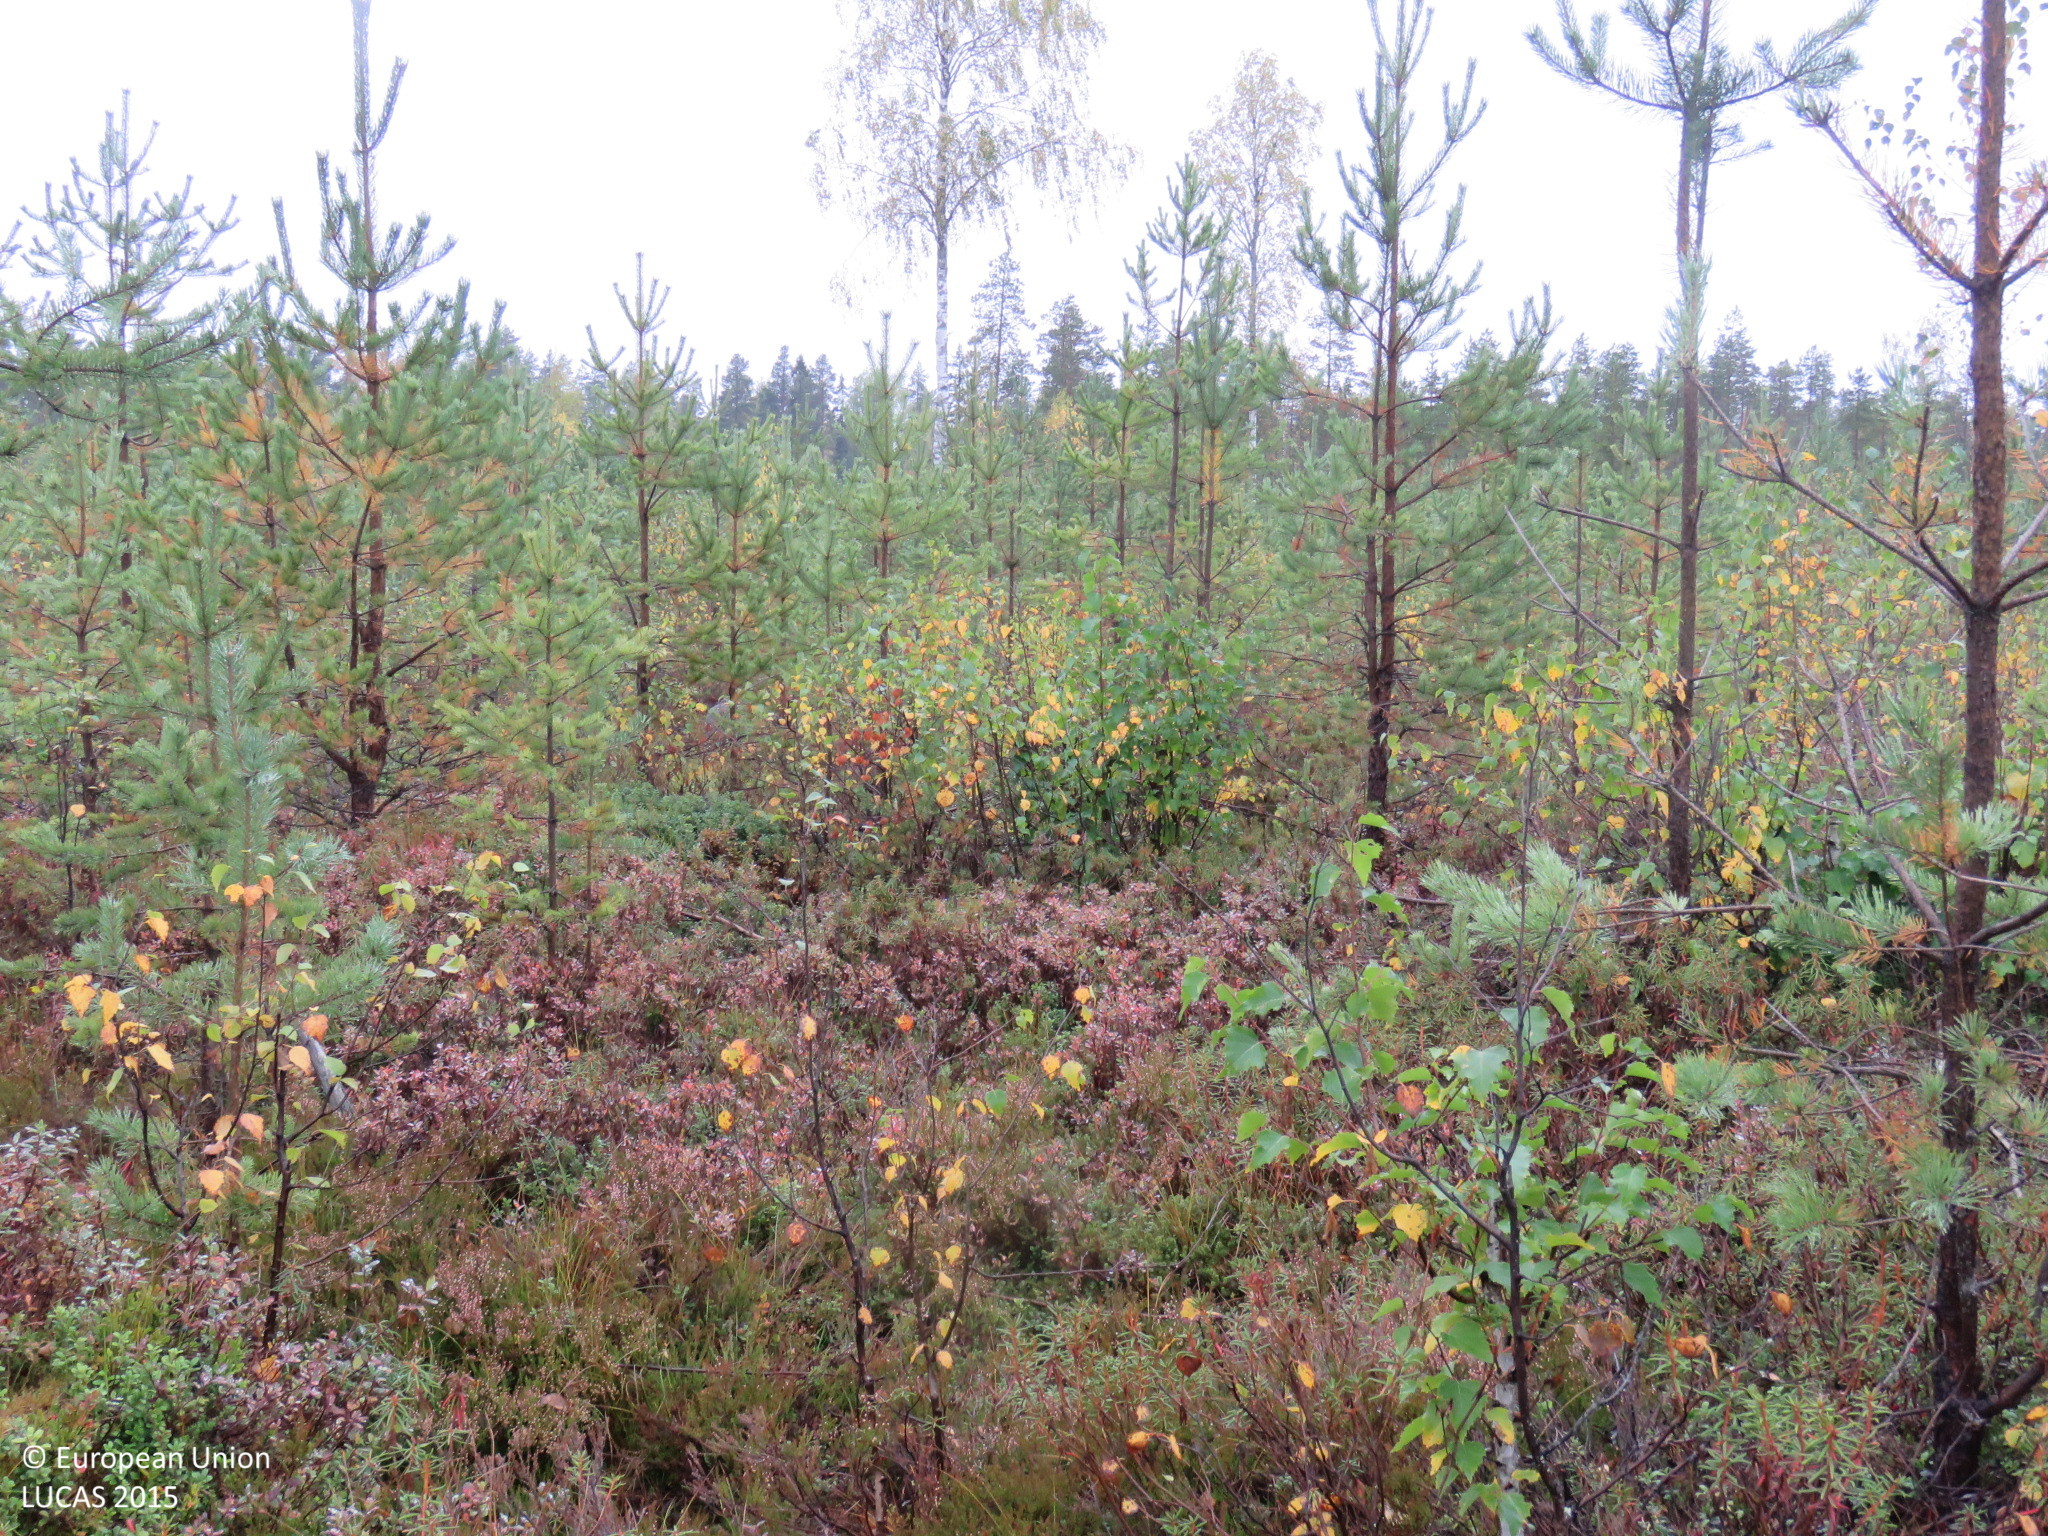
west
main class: Woodland
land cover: Pine dominated mixed woodland
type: boreal forest
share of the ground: 50 - 75 %
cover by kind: coniferous forest trees 30 %, shrubs 30 %, broadleaved forest trees 20 %, lichens and mosses 15 %, herbaceous plants 5 %
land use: Forestry
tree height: < 5 m
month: September
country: FI
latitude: 64.8346
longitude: 26.5729
